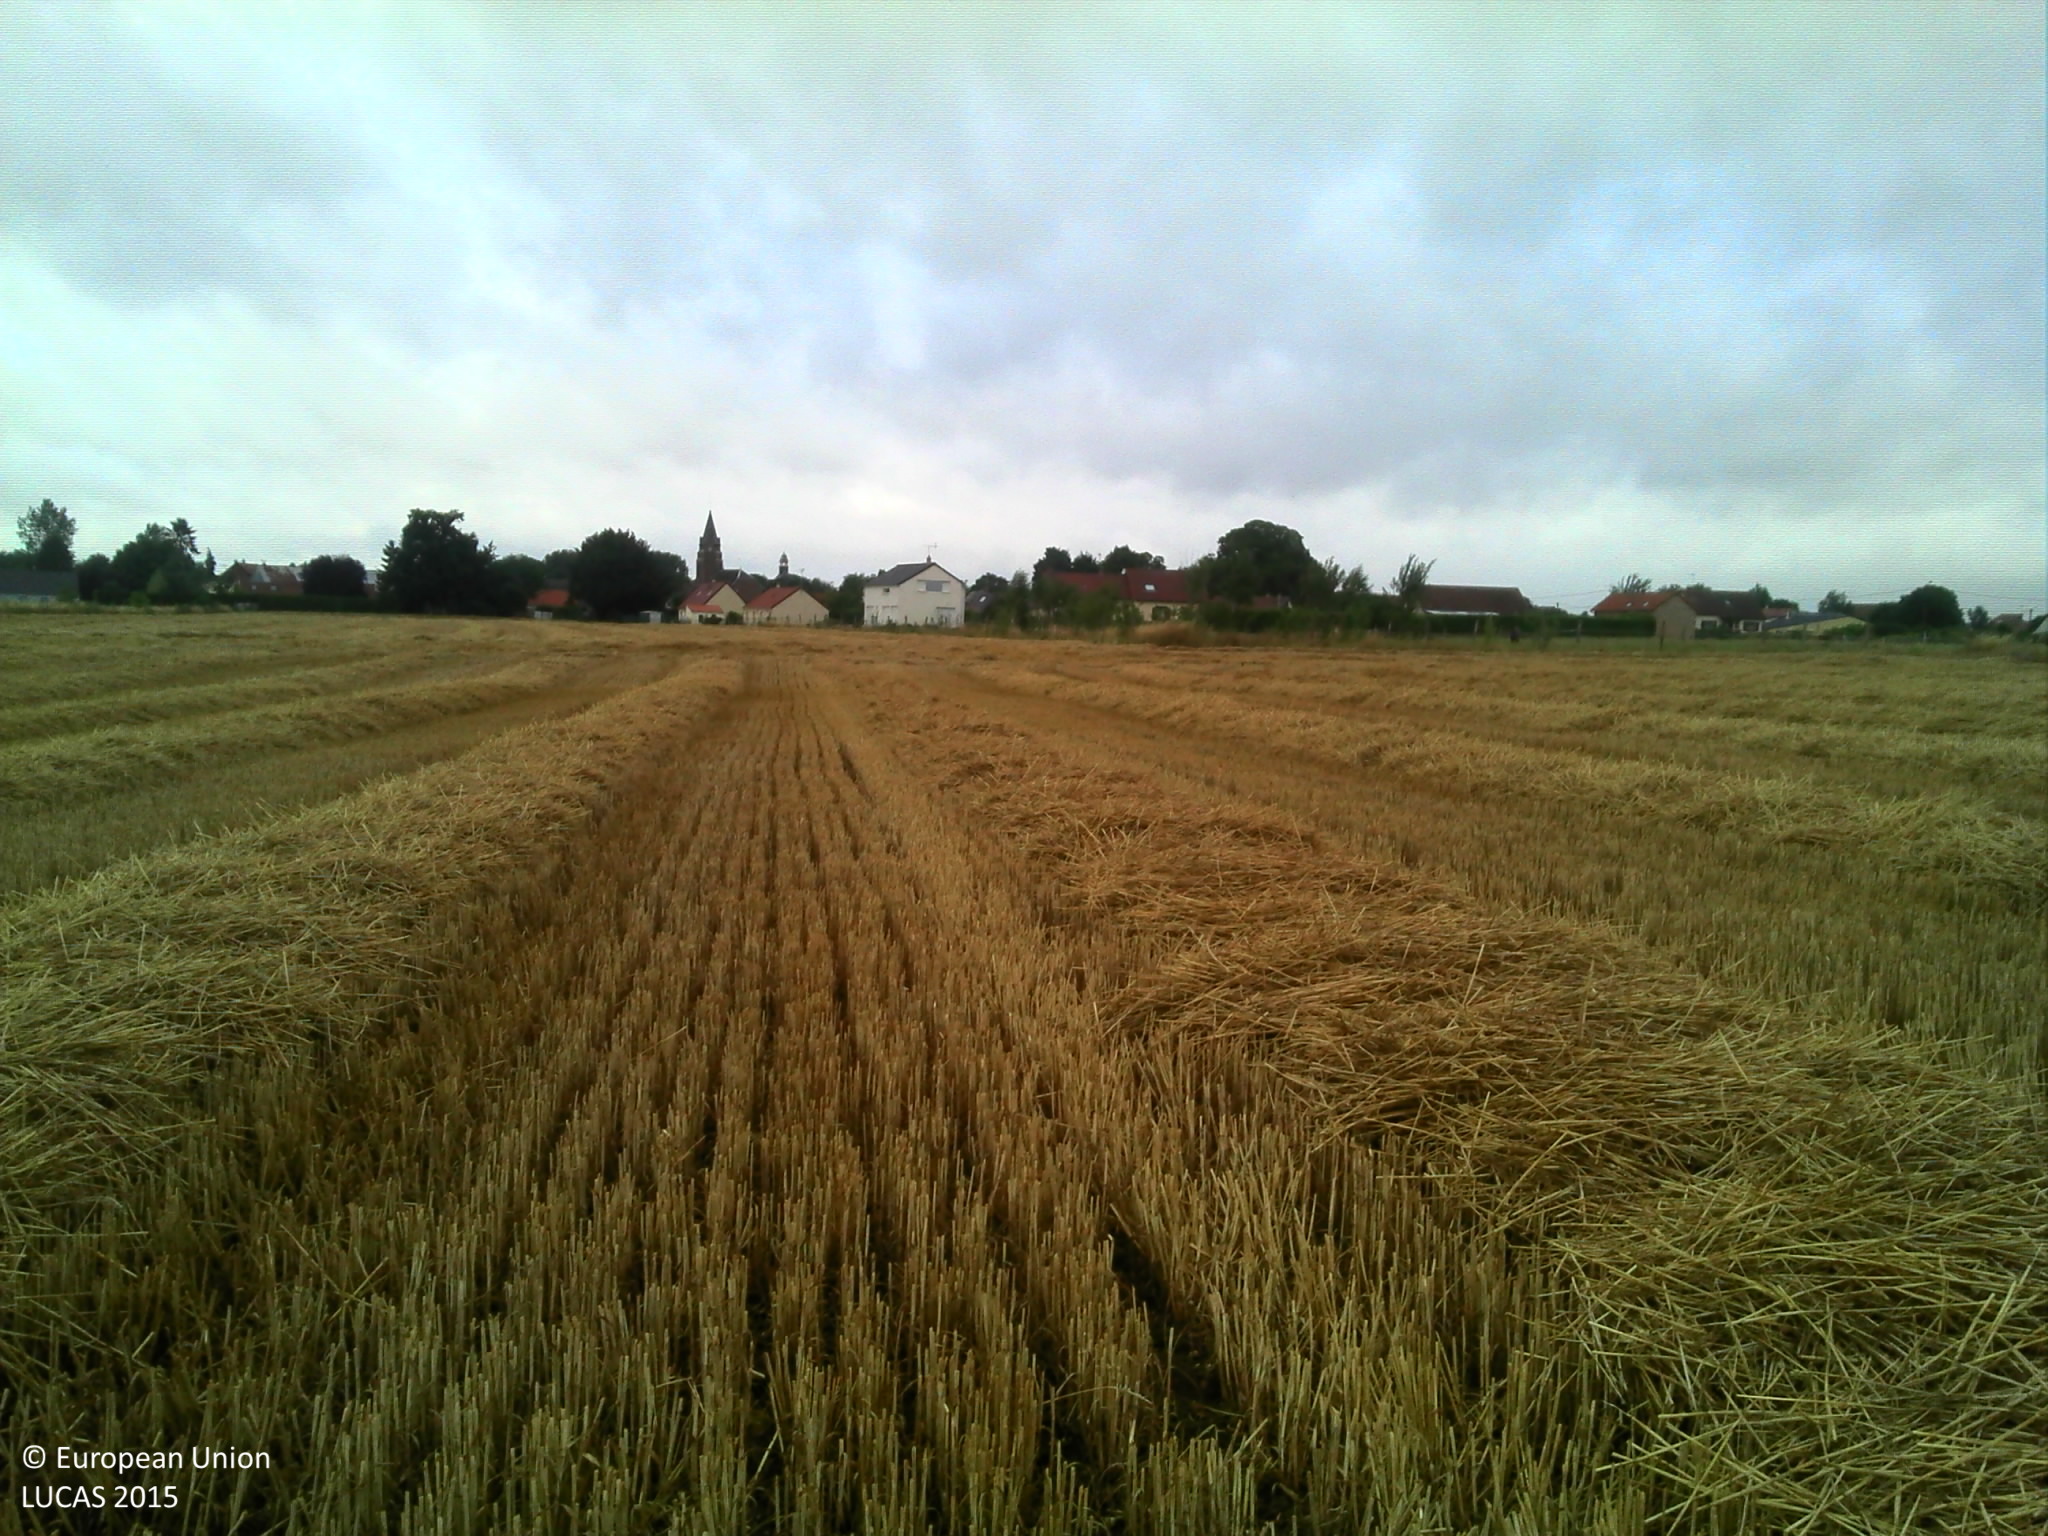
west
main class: Cropland
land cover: Common wheat
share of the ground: > 75 %
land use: Agriculture (excluding fallow land and kitchen gardens)
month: July
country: FR
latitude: 49.8444
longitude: 2.4643
